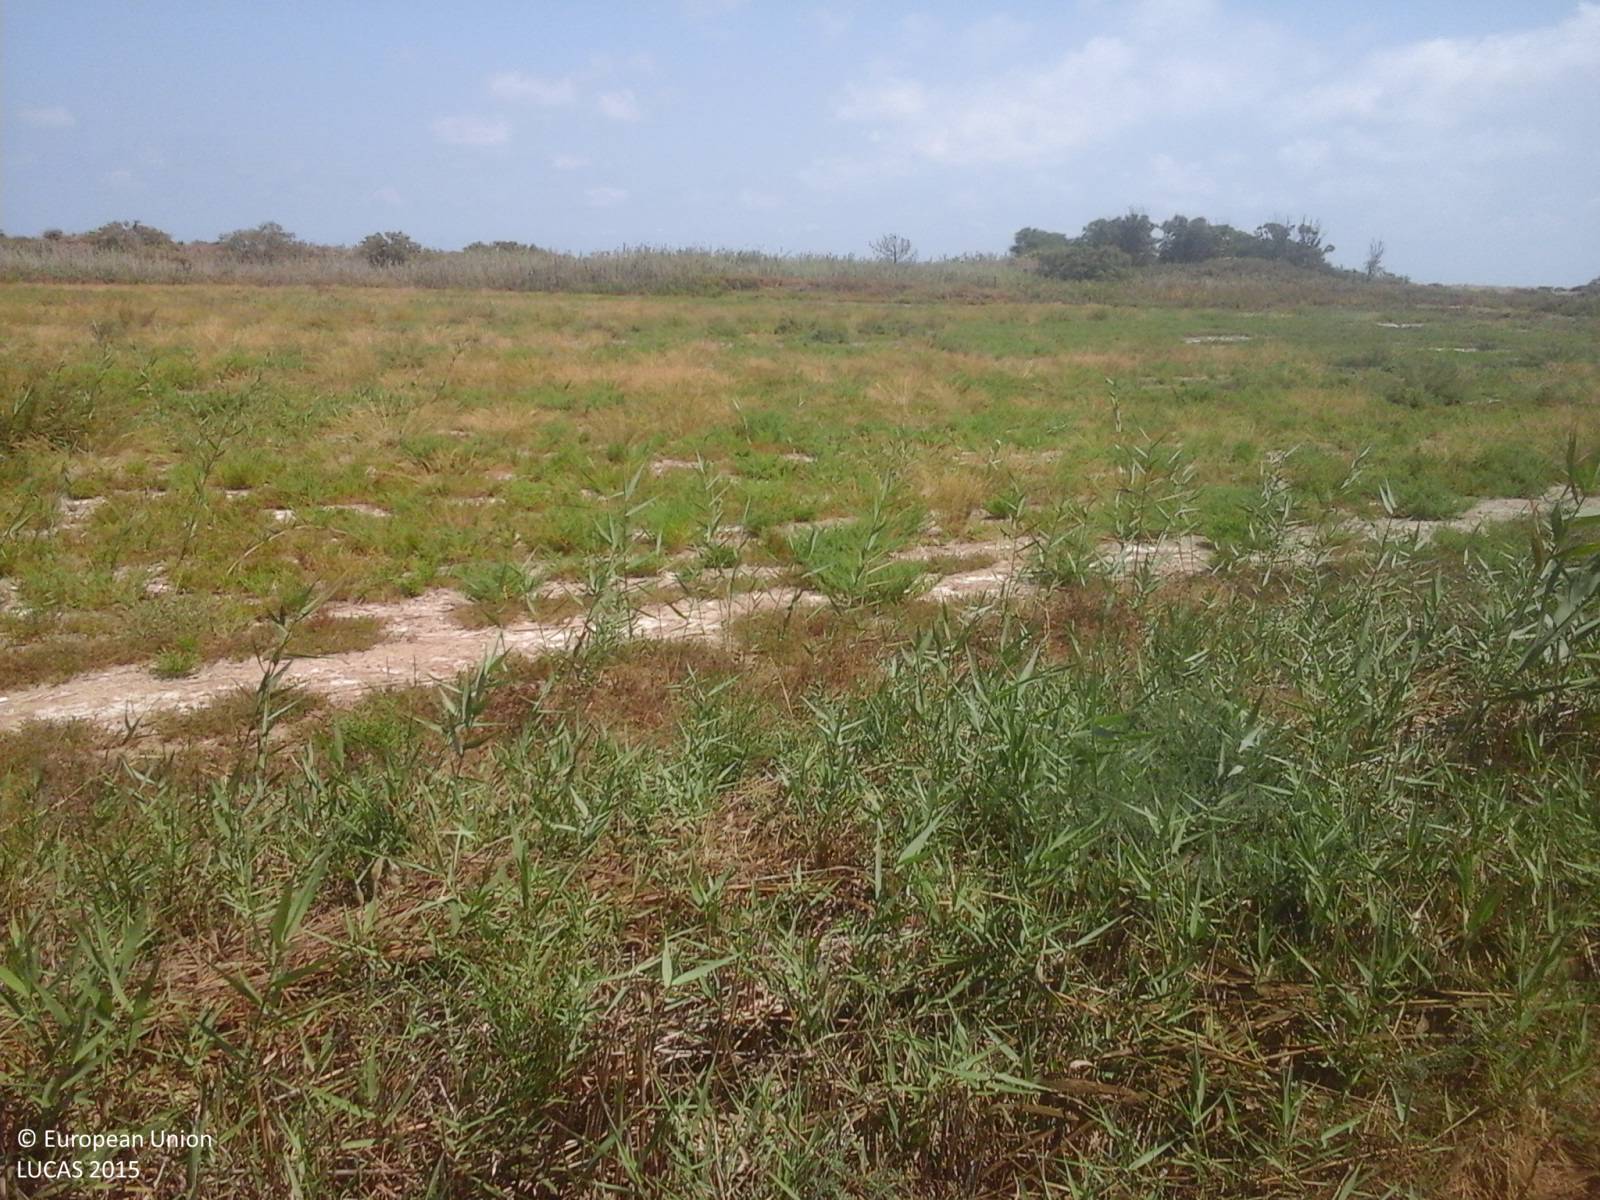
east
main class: Grassland
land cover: Spontaneously vegetated surfaces
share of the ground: > 75 %
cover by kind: herbaceous plants 75 %, unconsolidated bare surface 25 %
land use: Fallow land
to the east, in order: Spontaneously vegetated surfaces; Ditches and canals; Tracks; Ditches and canals; Spontaneously vegetated surfaces; Shrubland without tree cover; Inland fresh running water; Shrubland without tree cover; Sand
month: July
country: IT
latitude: 39.4154
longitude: 9.6190
